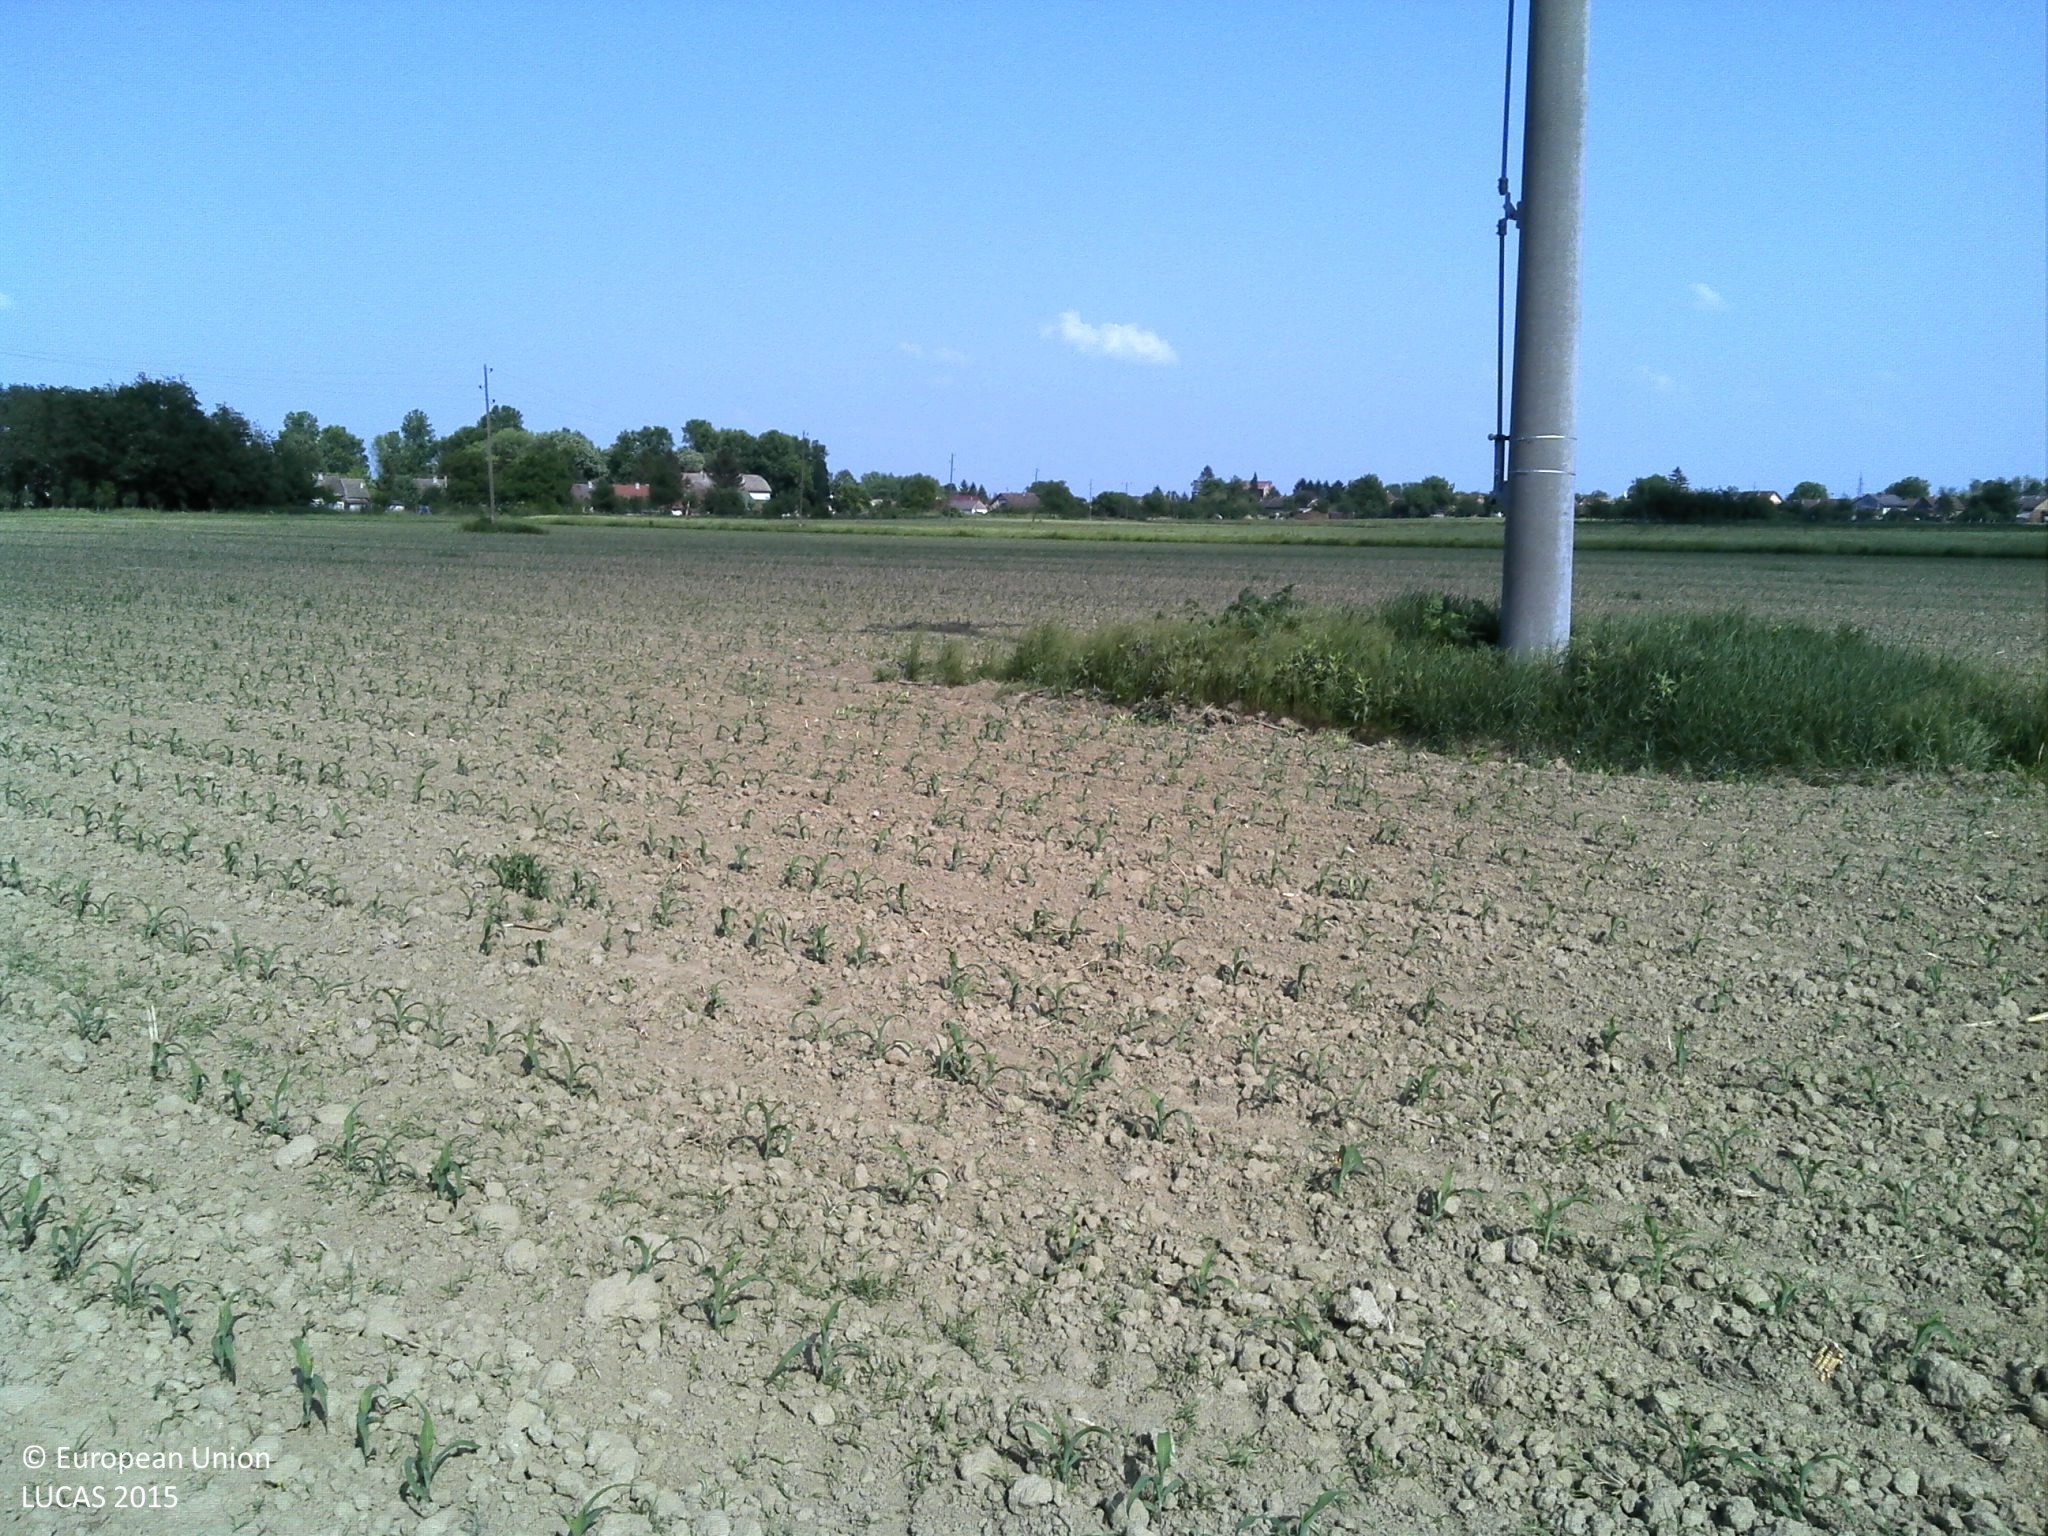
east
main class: Cropland
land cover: Maize
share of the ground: < 10 %
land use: Agriculture (excluding fallow land and kitchen gardens)
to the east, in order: Maize; Electric lines; Grass margins; Tracks; Grass margins; Common wheat
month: May
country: HR
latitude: 45.7031
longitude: 18.2904
